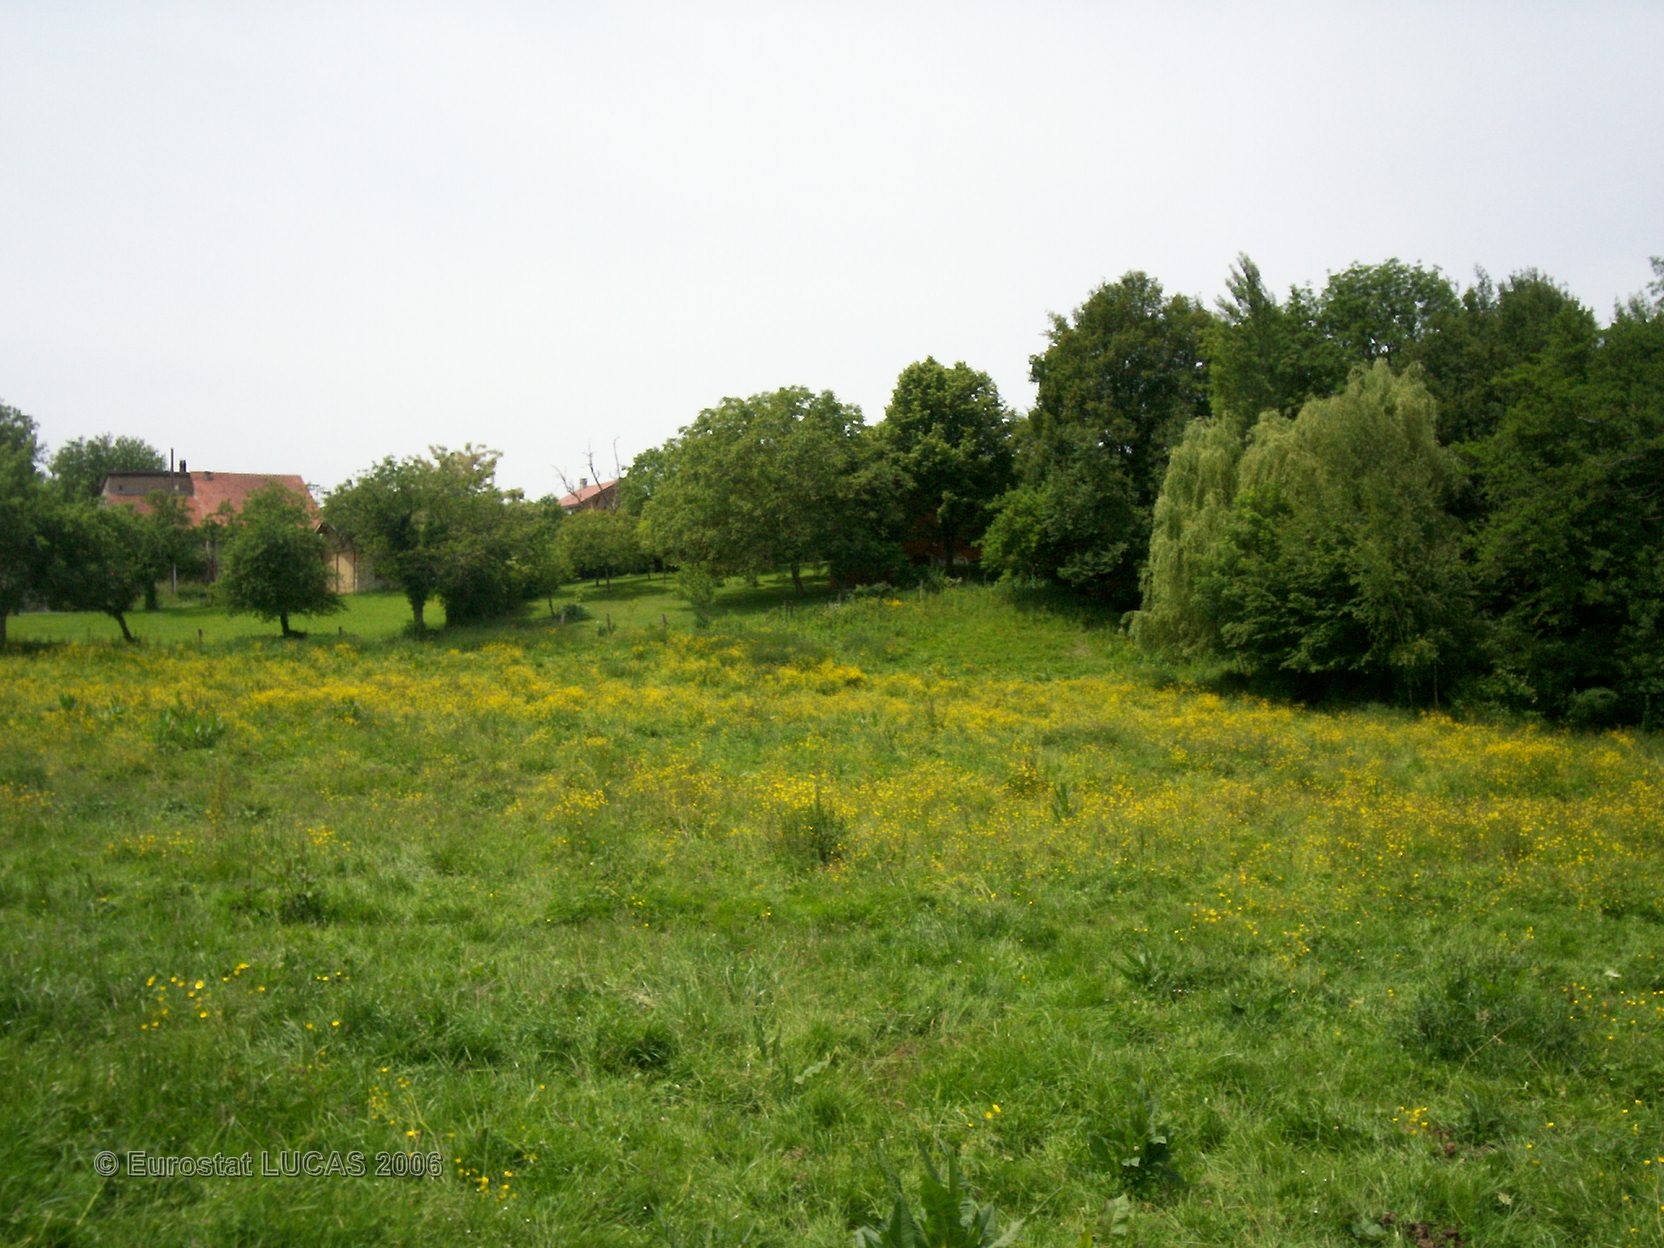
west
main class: Grassland
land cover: Grassland without tree/shrub cover
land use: Agriculture (excluding fallow land and kitchen gardens)
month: June
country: FR
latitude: 46.3269
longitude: 6.4053
